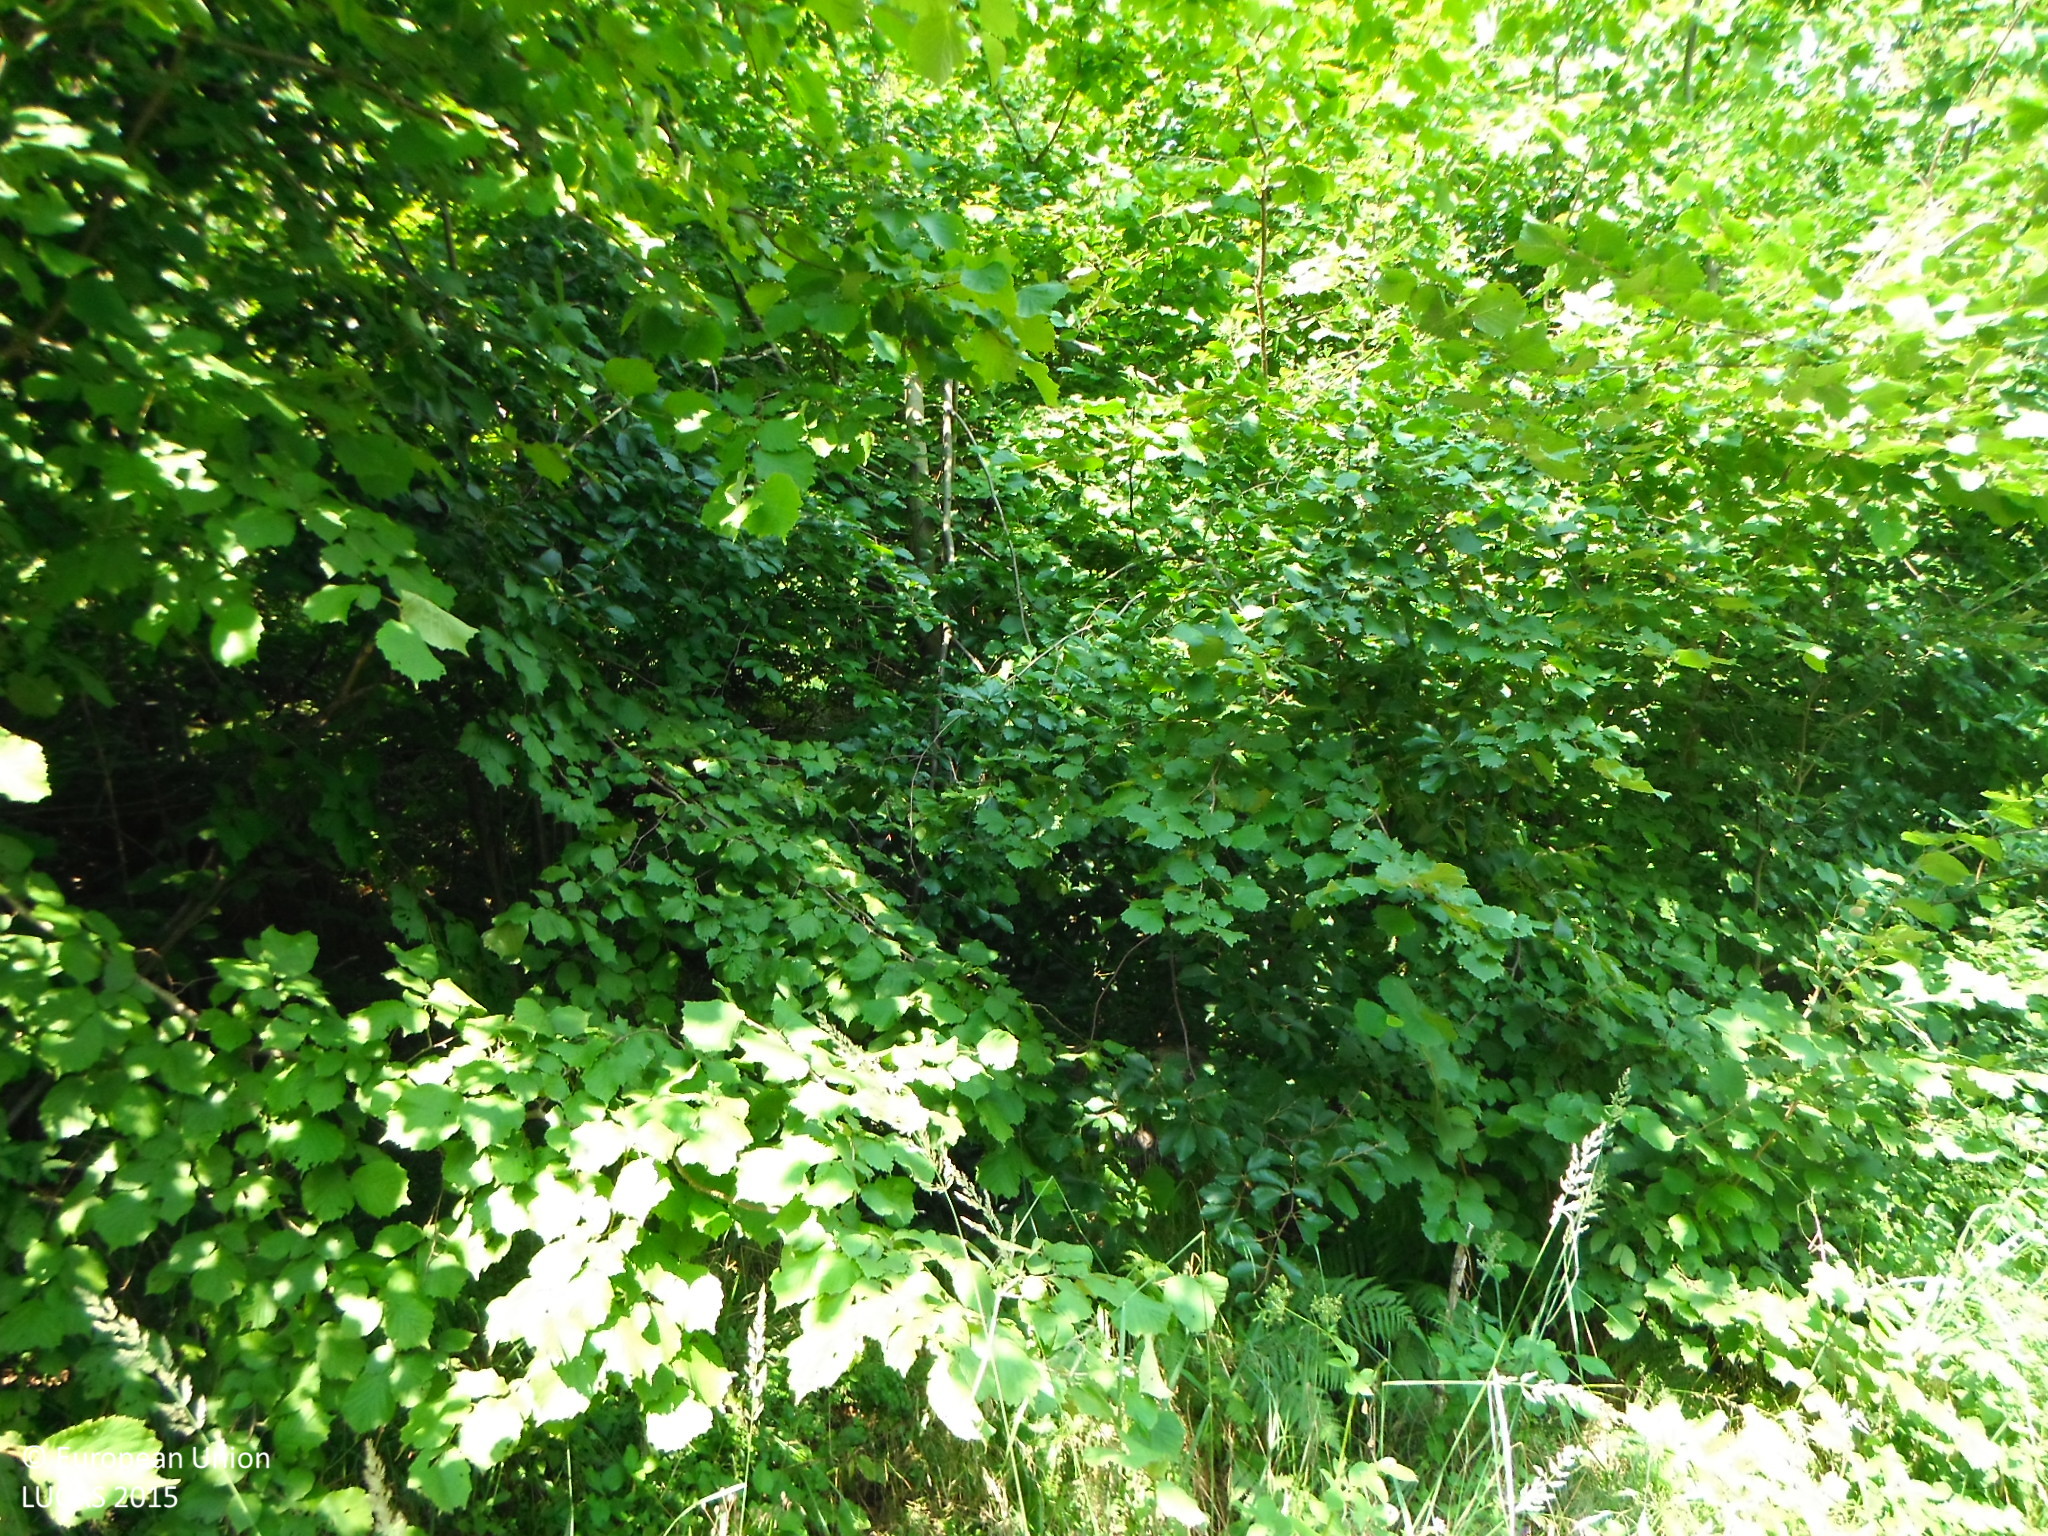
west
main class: Shrubland
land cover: Shrubland with sparse tree cover
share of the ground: > 75 %
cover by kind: shrubs 95 %, broadleaved forest trees 5 %
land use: Semi-natural and natural areas not in use
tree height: > 5 m
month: August
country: SK
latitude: 48.7424
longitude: 20.2453
